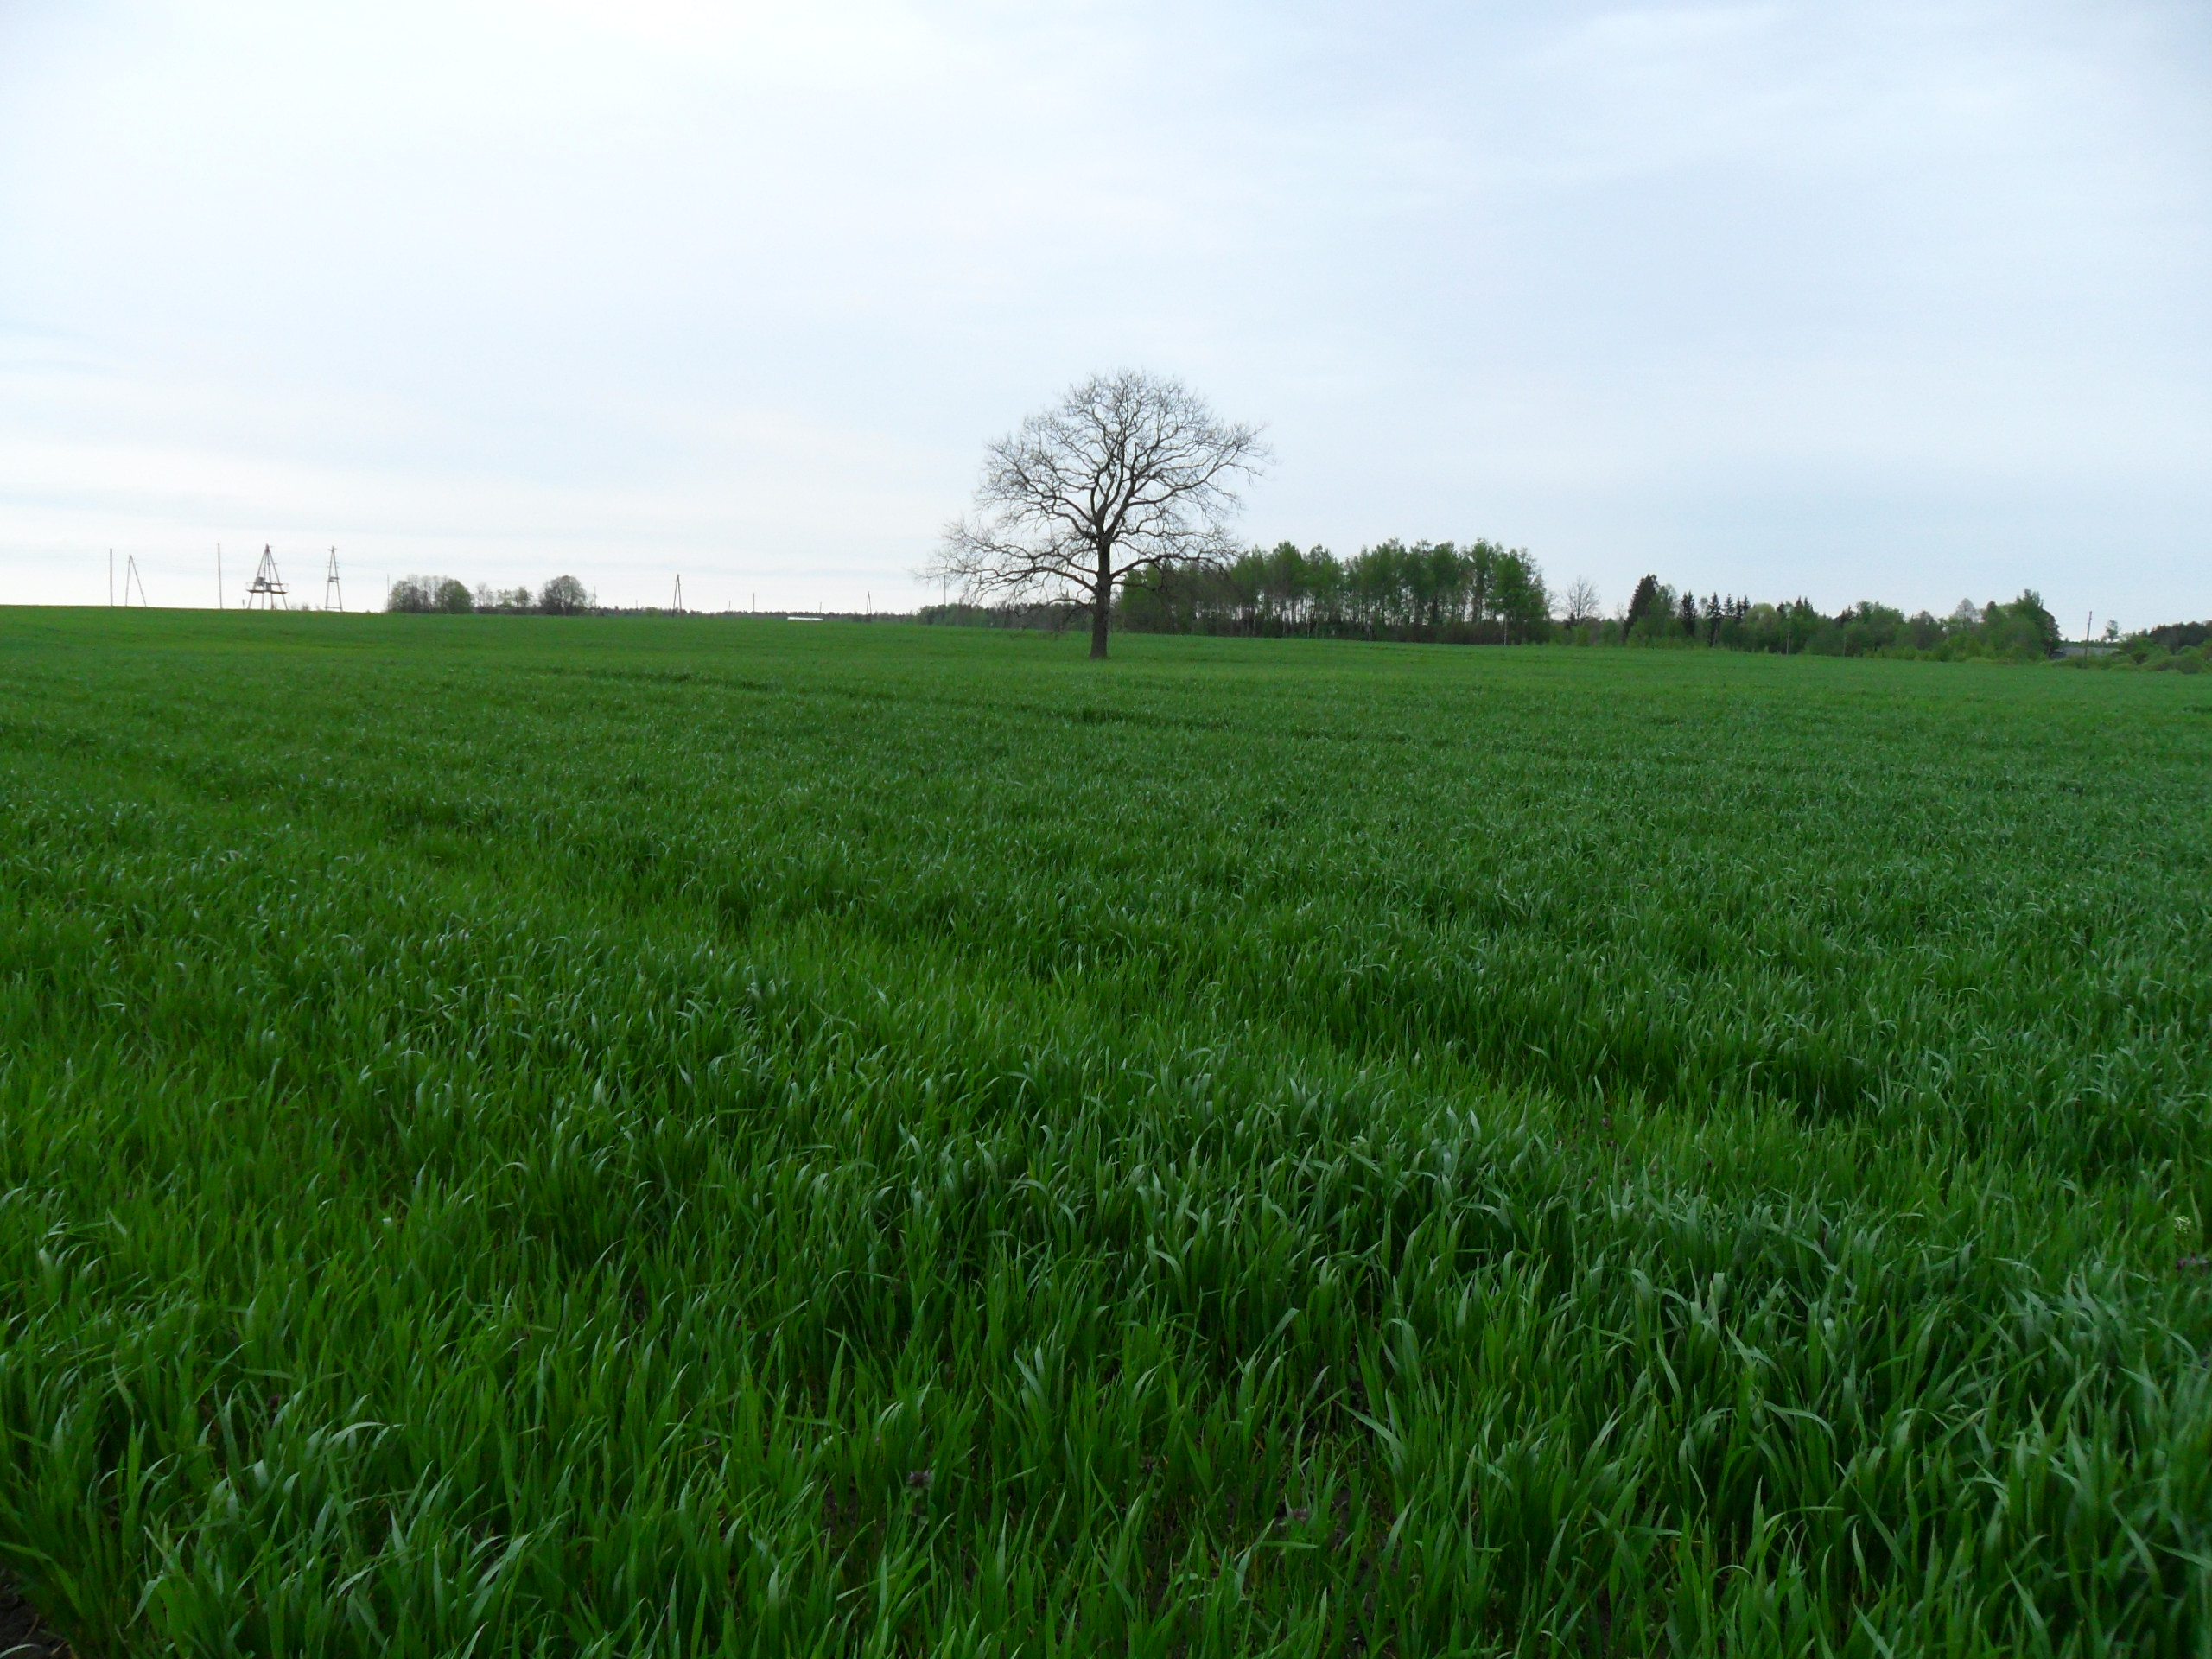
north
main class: Cropland
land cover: Common wheat
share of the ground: > 75 %
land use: Agriculture (excluding fallow land and kitchen gardens)
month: May
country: LV
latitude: 57.2999
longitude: 22.5517
